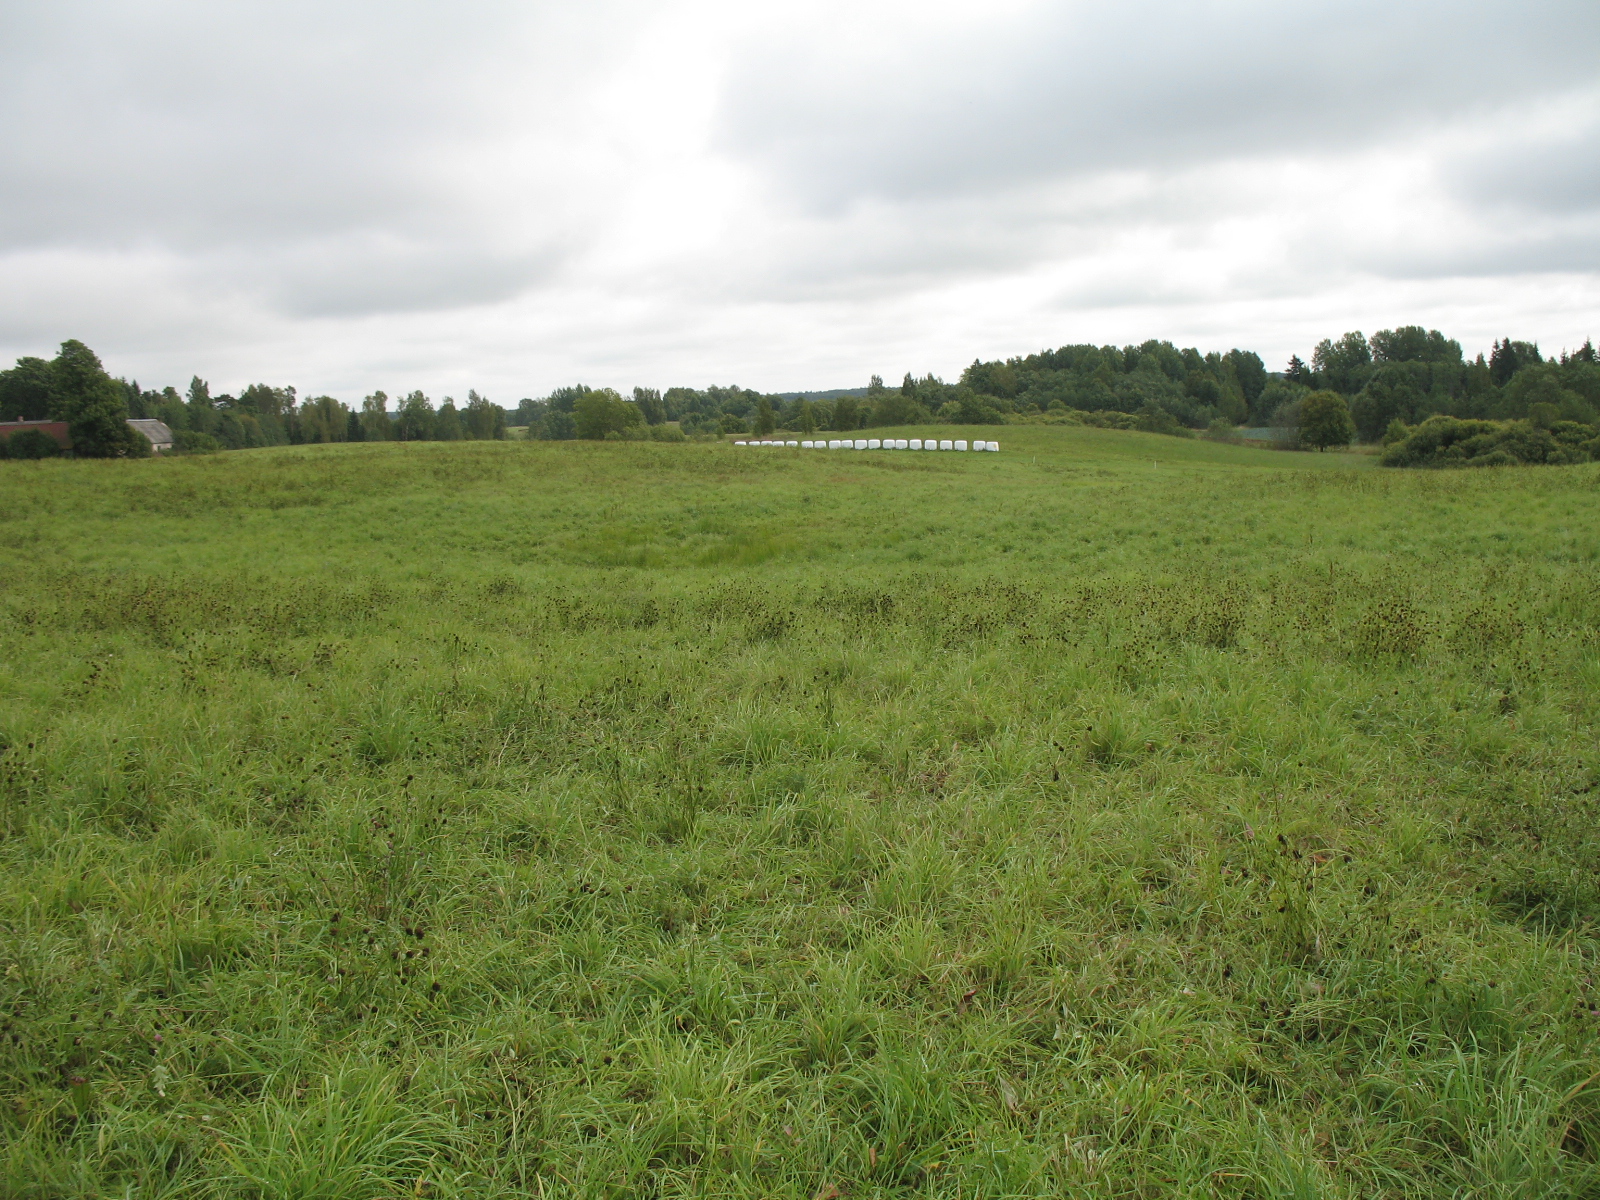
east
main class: Grassland
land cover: Grassland without tree/shrub cover
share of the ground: > 75 %
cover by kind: herbaceous plants 100 %
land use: Agriculture (excluding fallow land and kitchen gardens)
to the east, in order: Grassland without tree/shrub cover; Fences; Grassland without tree/shrub cover
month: September
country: LV
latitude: 56.0419
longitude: 26.1106
